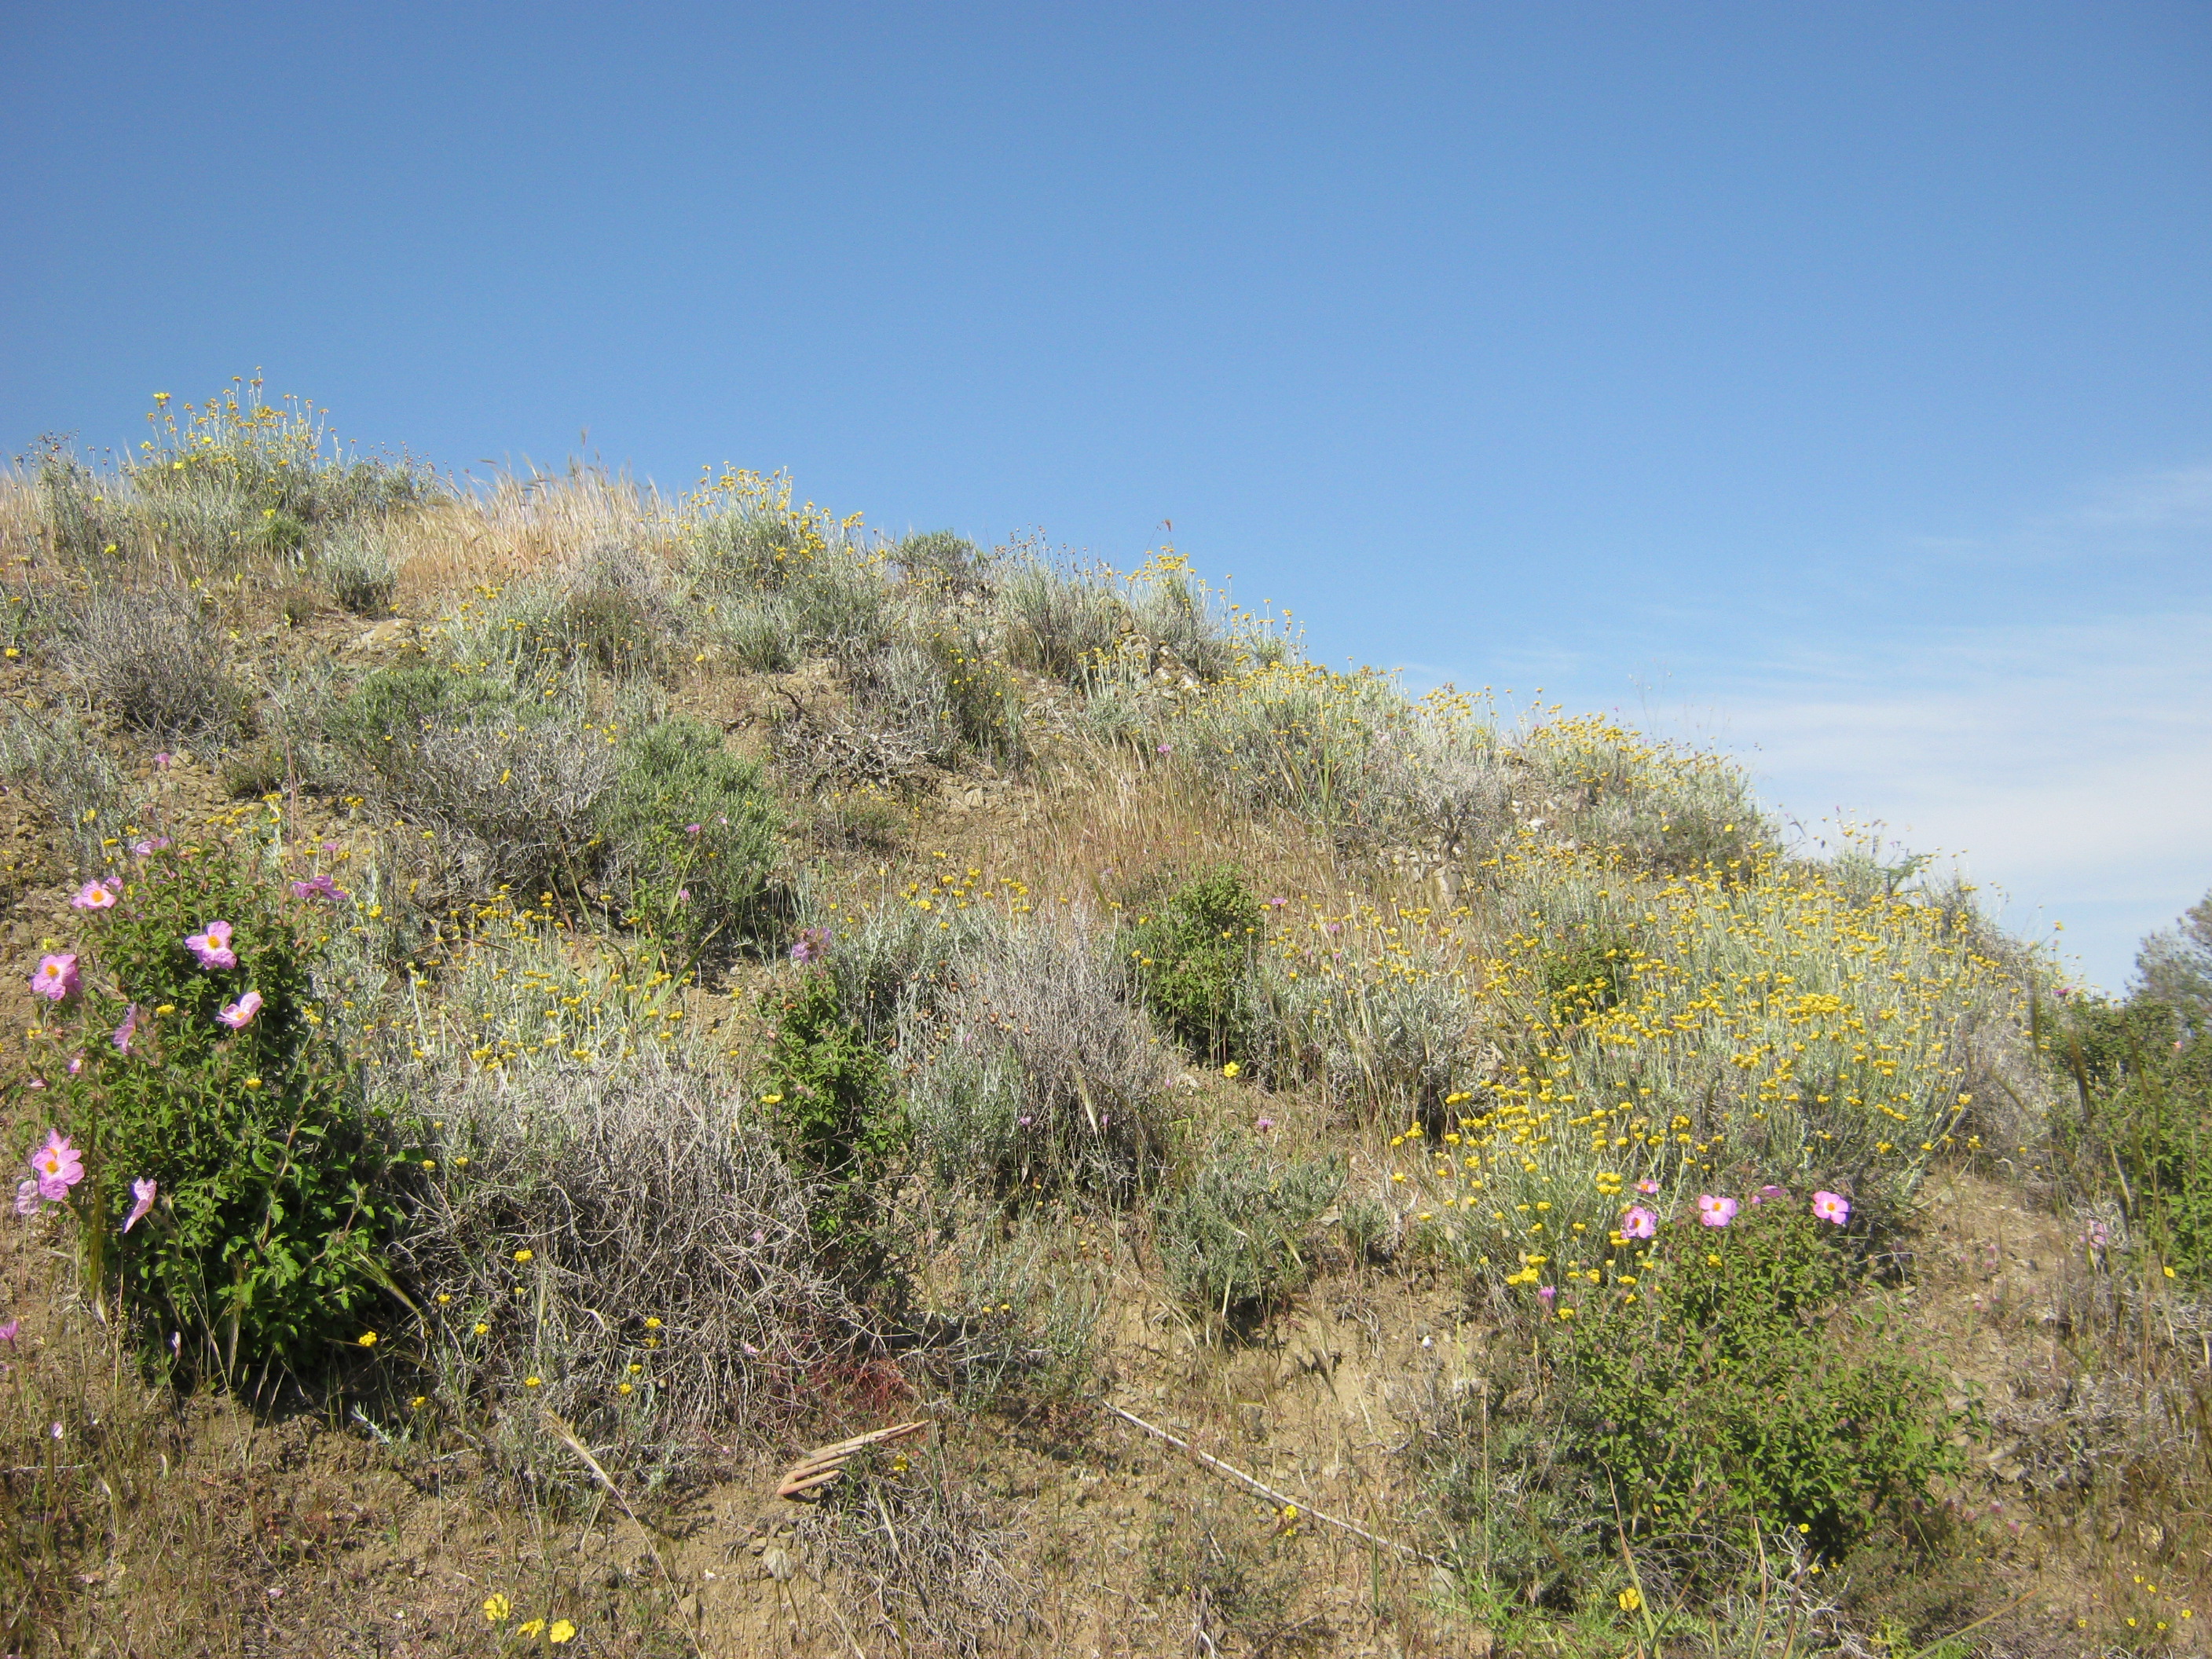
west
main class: Shrubland
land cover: Shrubland with sparse tree cover
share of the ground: 25 - 50 %
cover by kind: herbaceous plants 50 %, shrubs 45 %, broadleaved forest trees 5 %
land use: Semi-natural and natural areas not in use
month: April
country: CY
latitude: 34.9608
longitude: 33.3718
